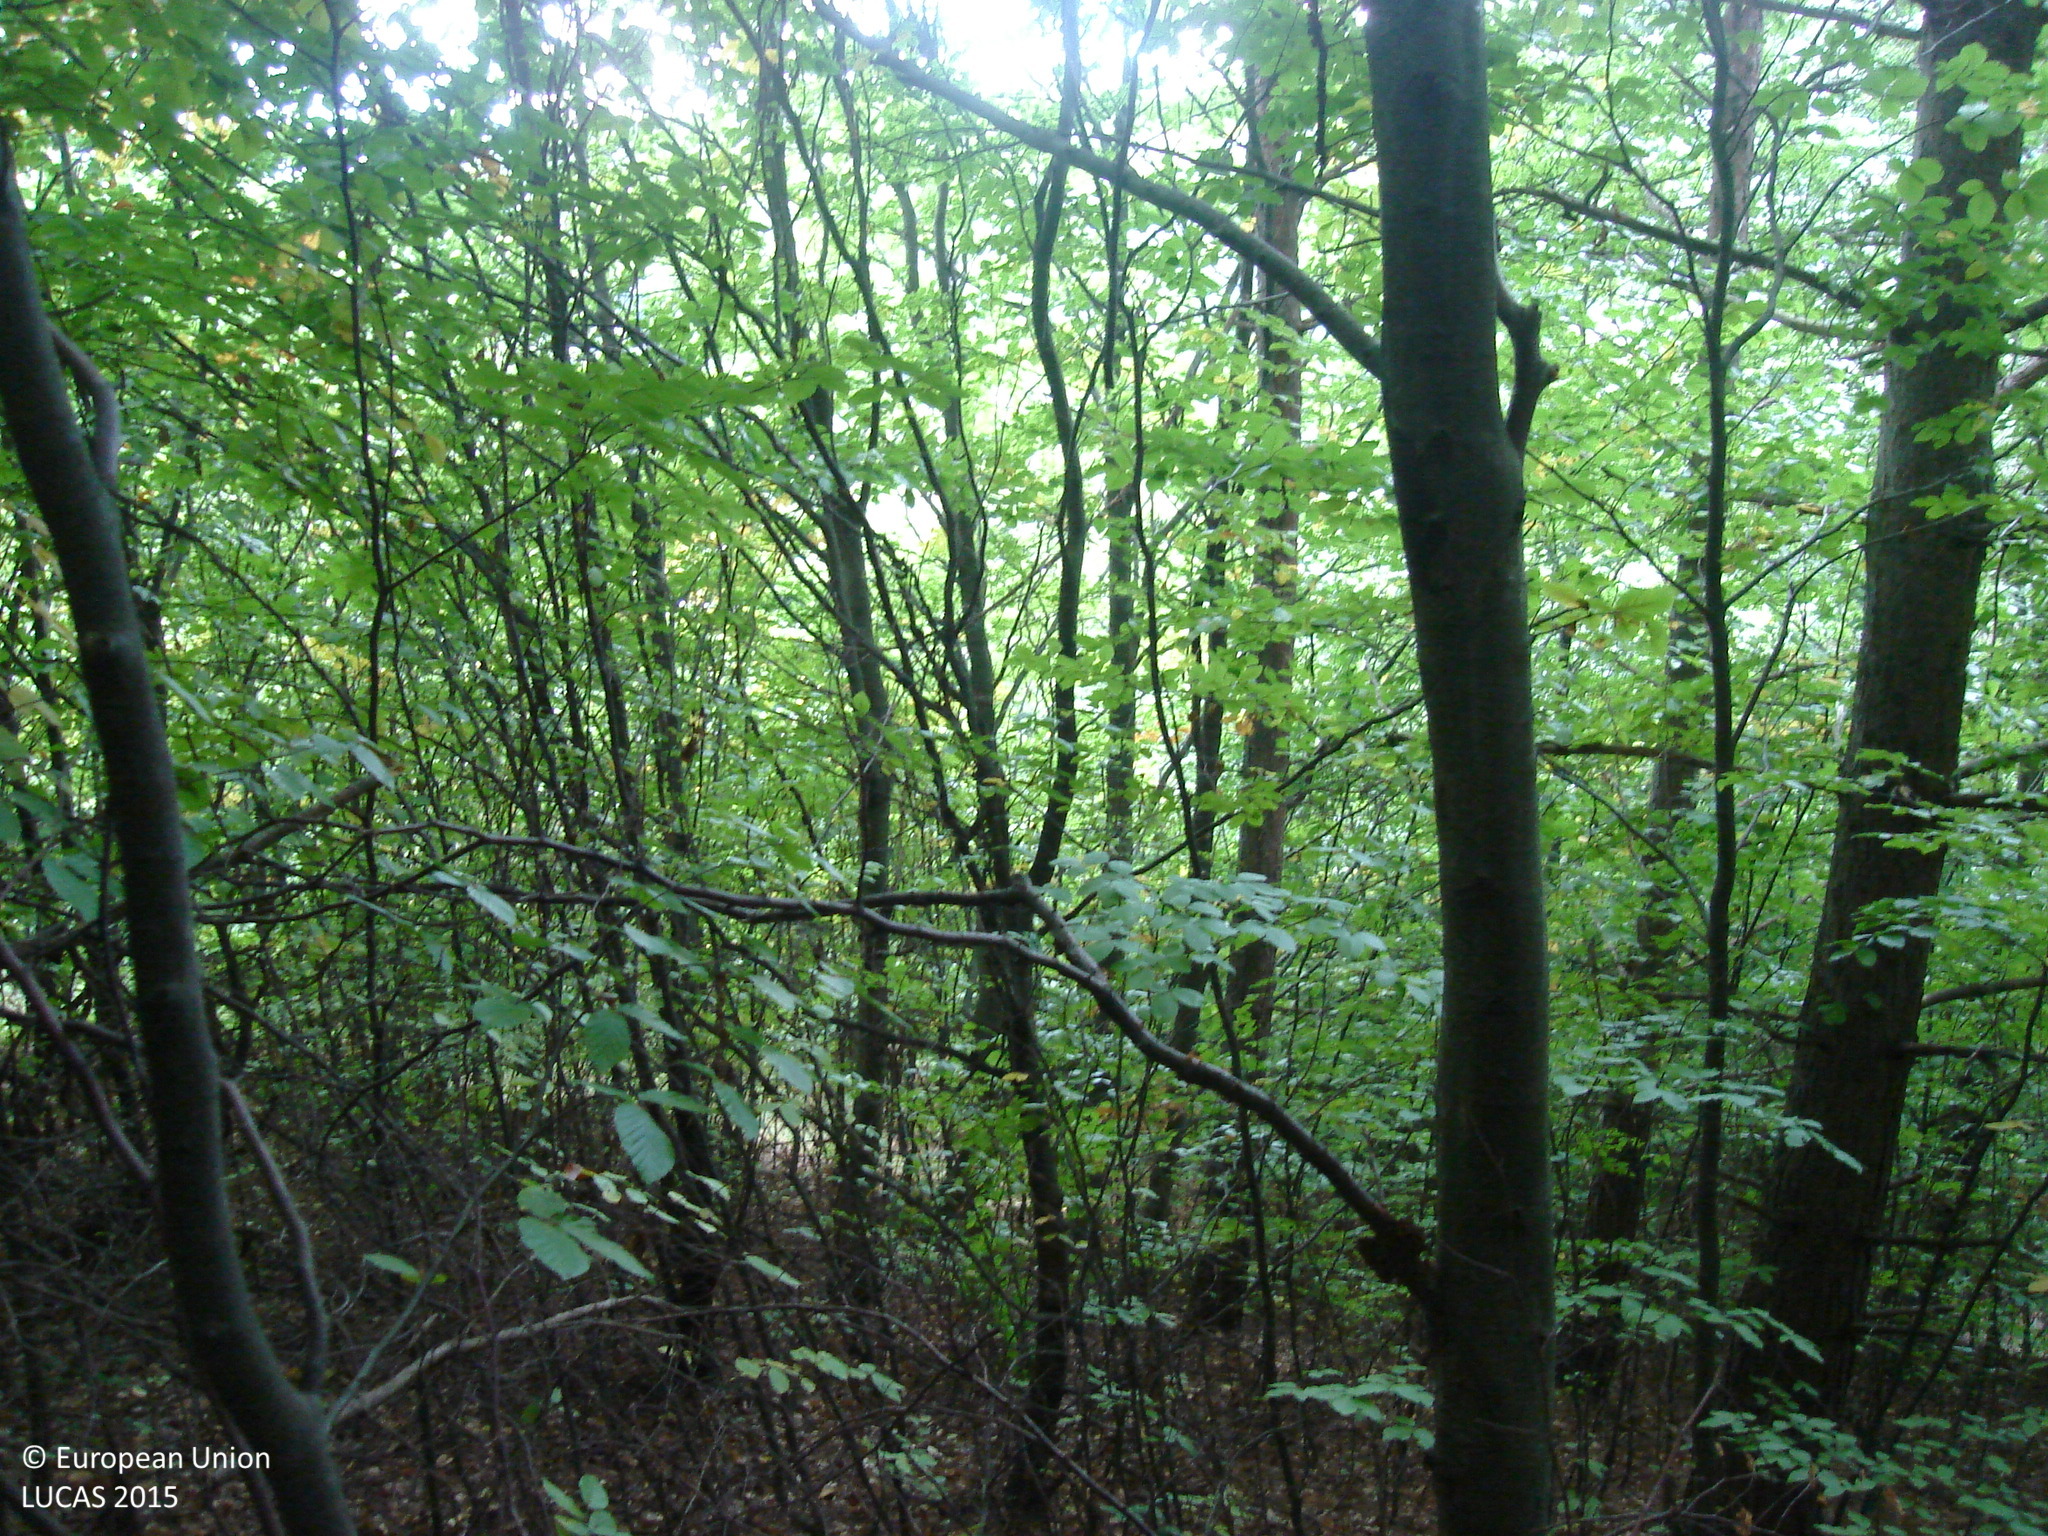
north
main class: Woodland
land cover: Spruce dominated mixed woodland
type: hemiboreal forest and nemoral coniferous forest and mixed broadleaved-coniferous forest
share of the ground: > 75 %
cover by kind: coniferous forest trees 50 %, broadleaved forest trees 40 %, unconsolidated bare surface 10 %
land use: Forestry
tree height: > 5 m
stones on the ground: < 10 %
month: October
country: BG
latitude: 42.9991
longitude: 23.4215
